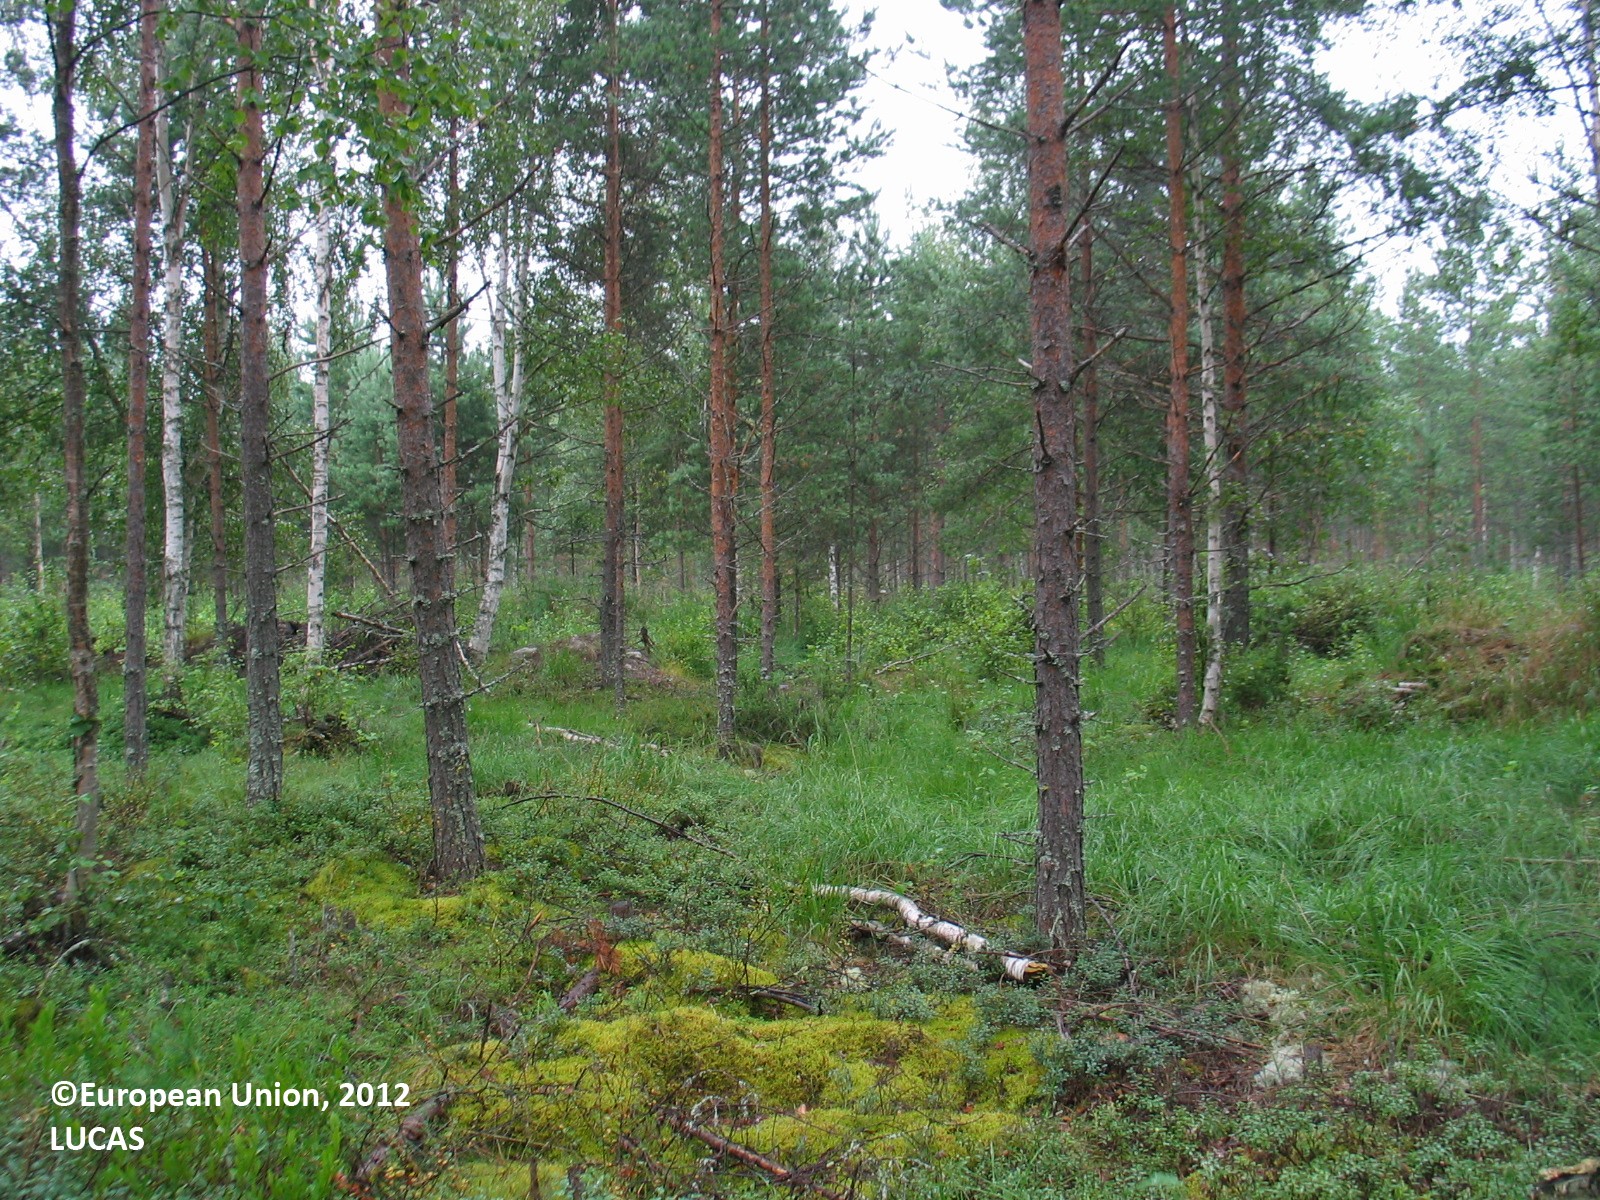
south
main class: Woodland
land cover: Pine dominated mixed woodland
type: mire and swamp forests
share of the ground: 25 - 50 %
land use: Forestry
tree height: > 5 m
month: August
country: FI
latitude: 64.5969
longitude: 25.9997
